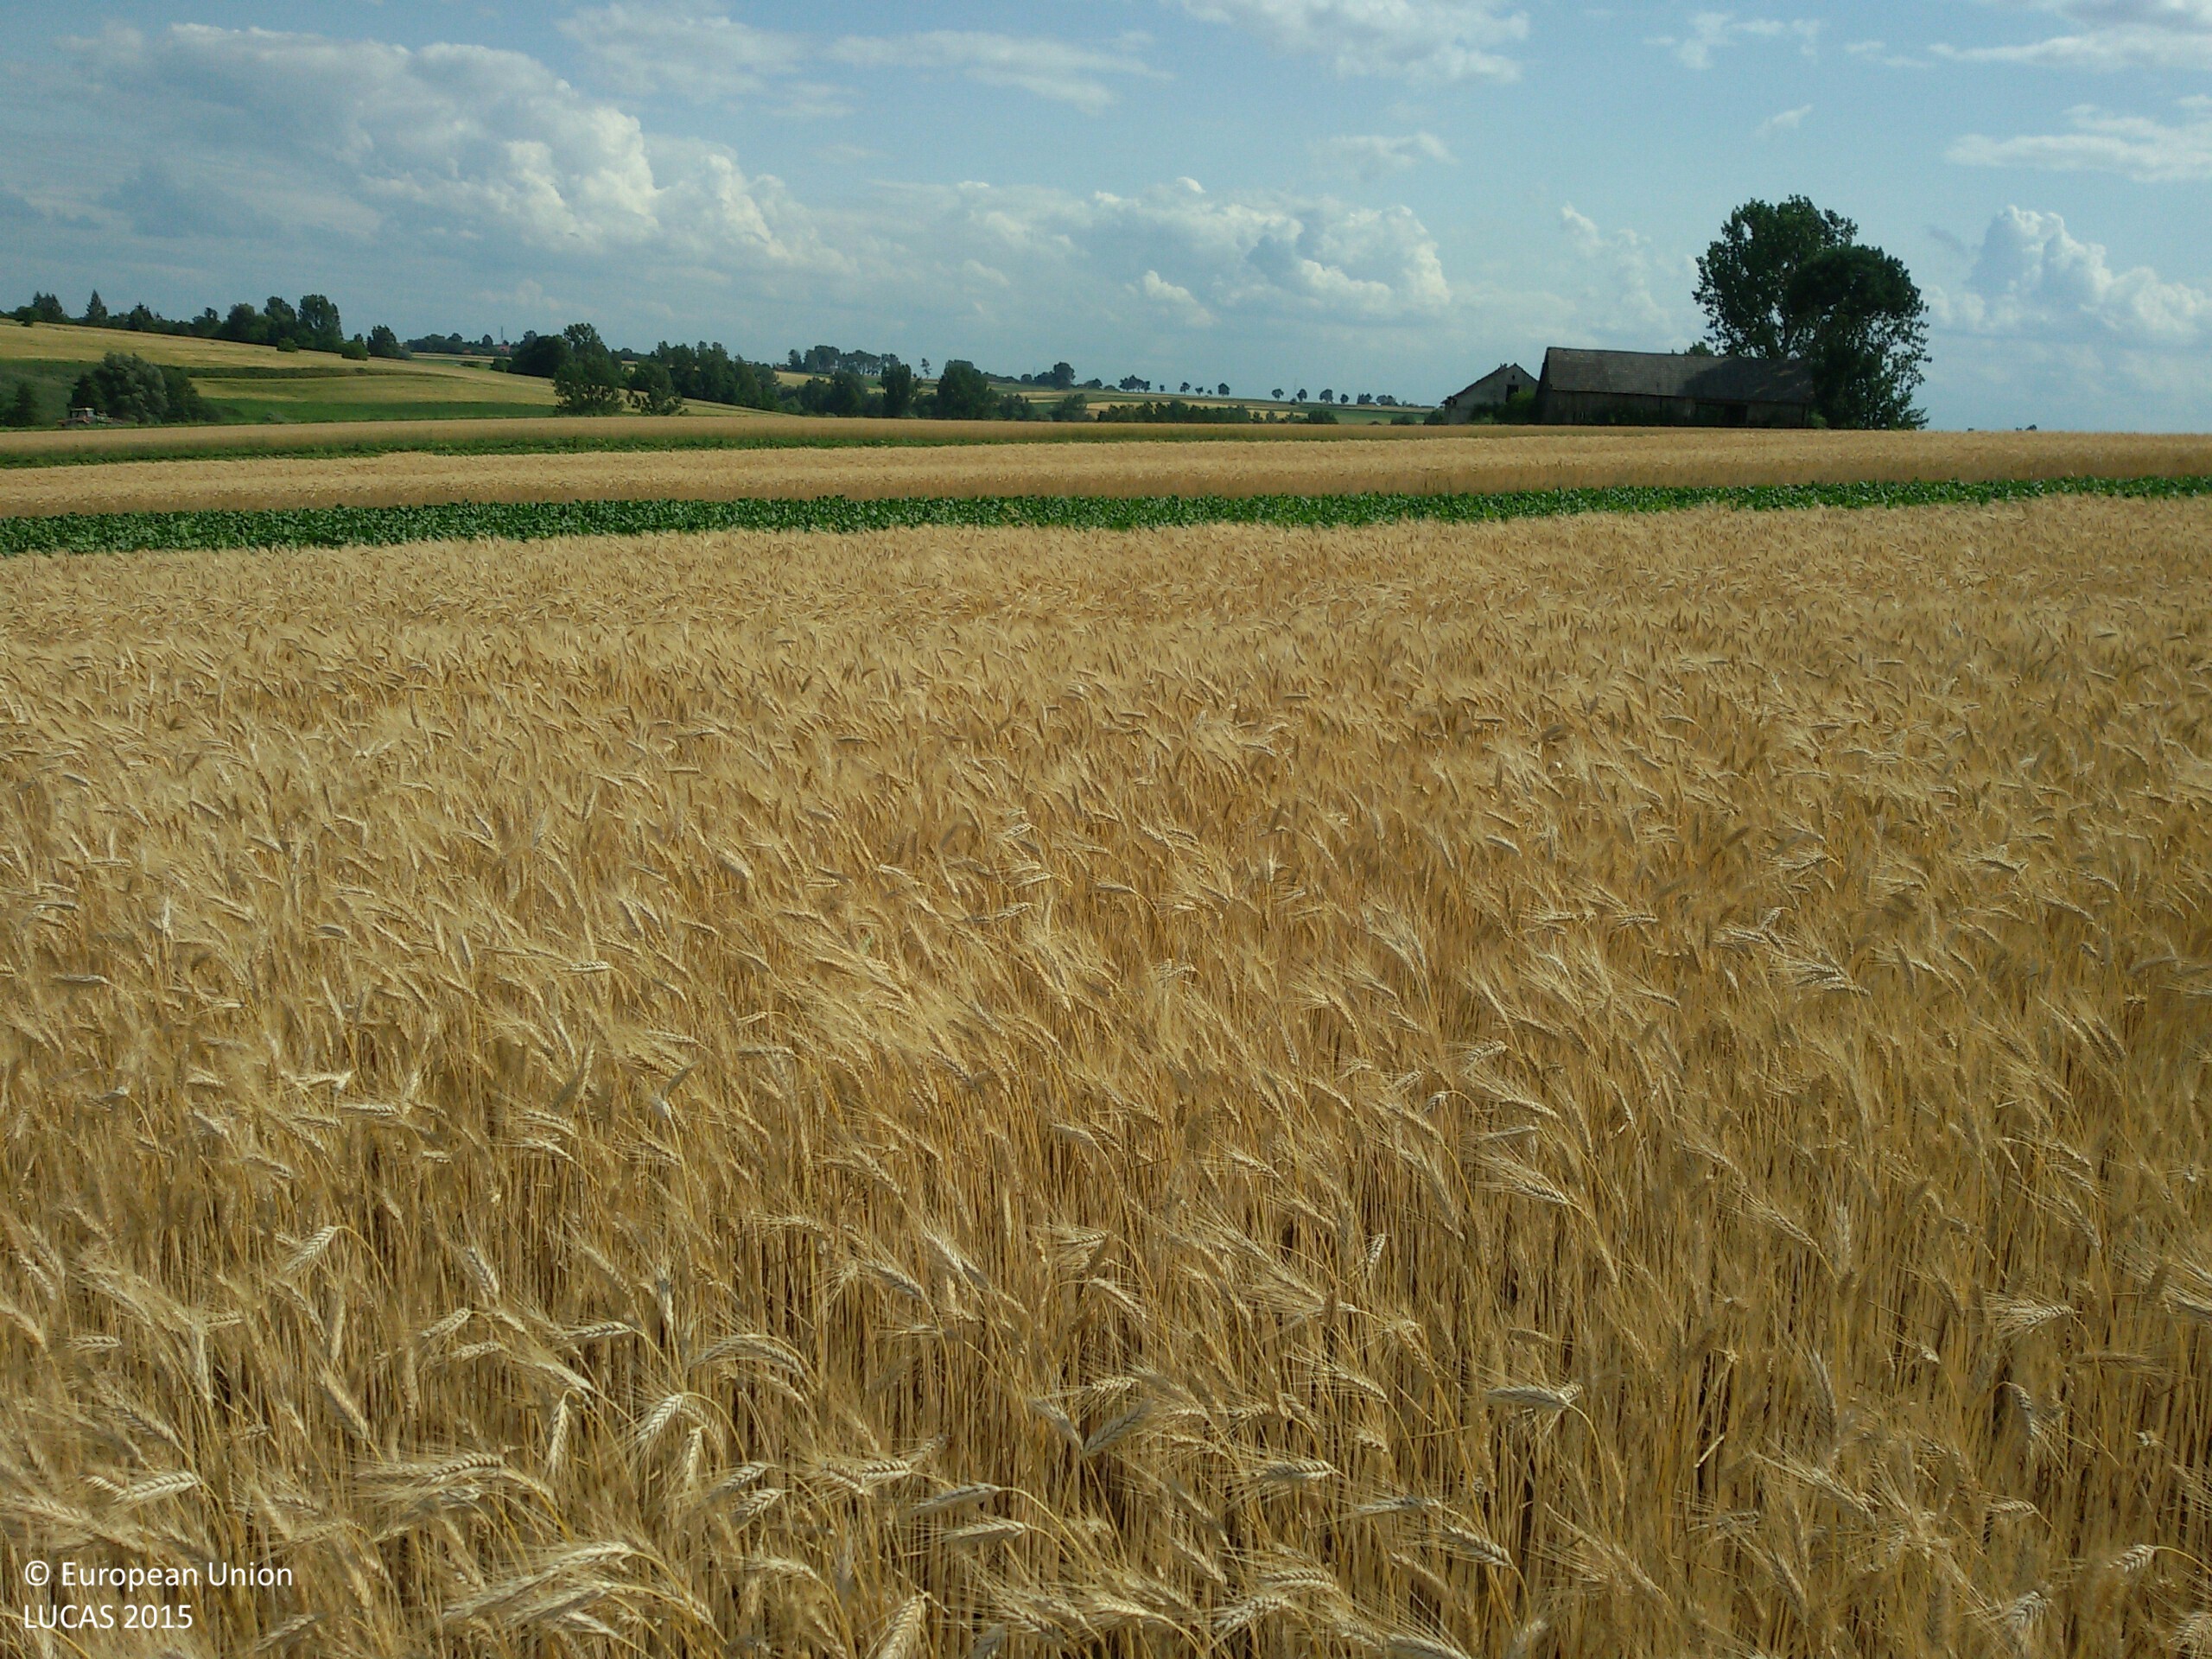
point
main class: Cropland
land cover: Triticale
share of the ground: > 75 %
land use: Agriculture (excluding fallow land and kitchen gardens)
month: July
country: PL
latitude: 50.3782
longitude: 20.4005
